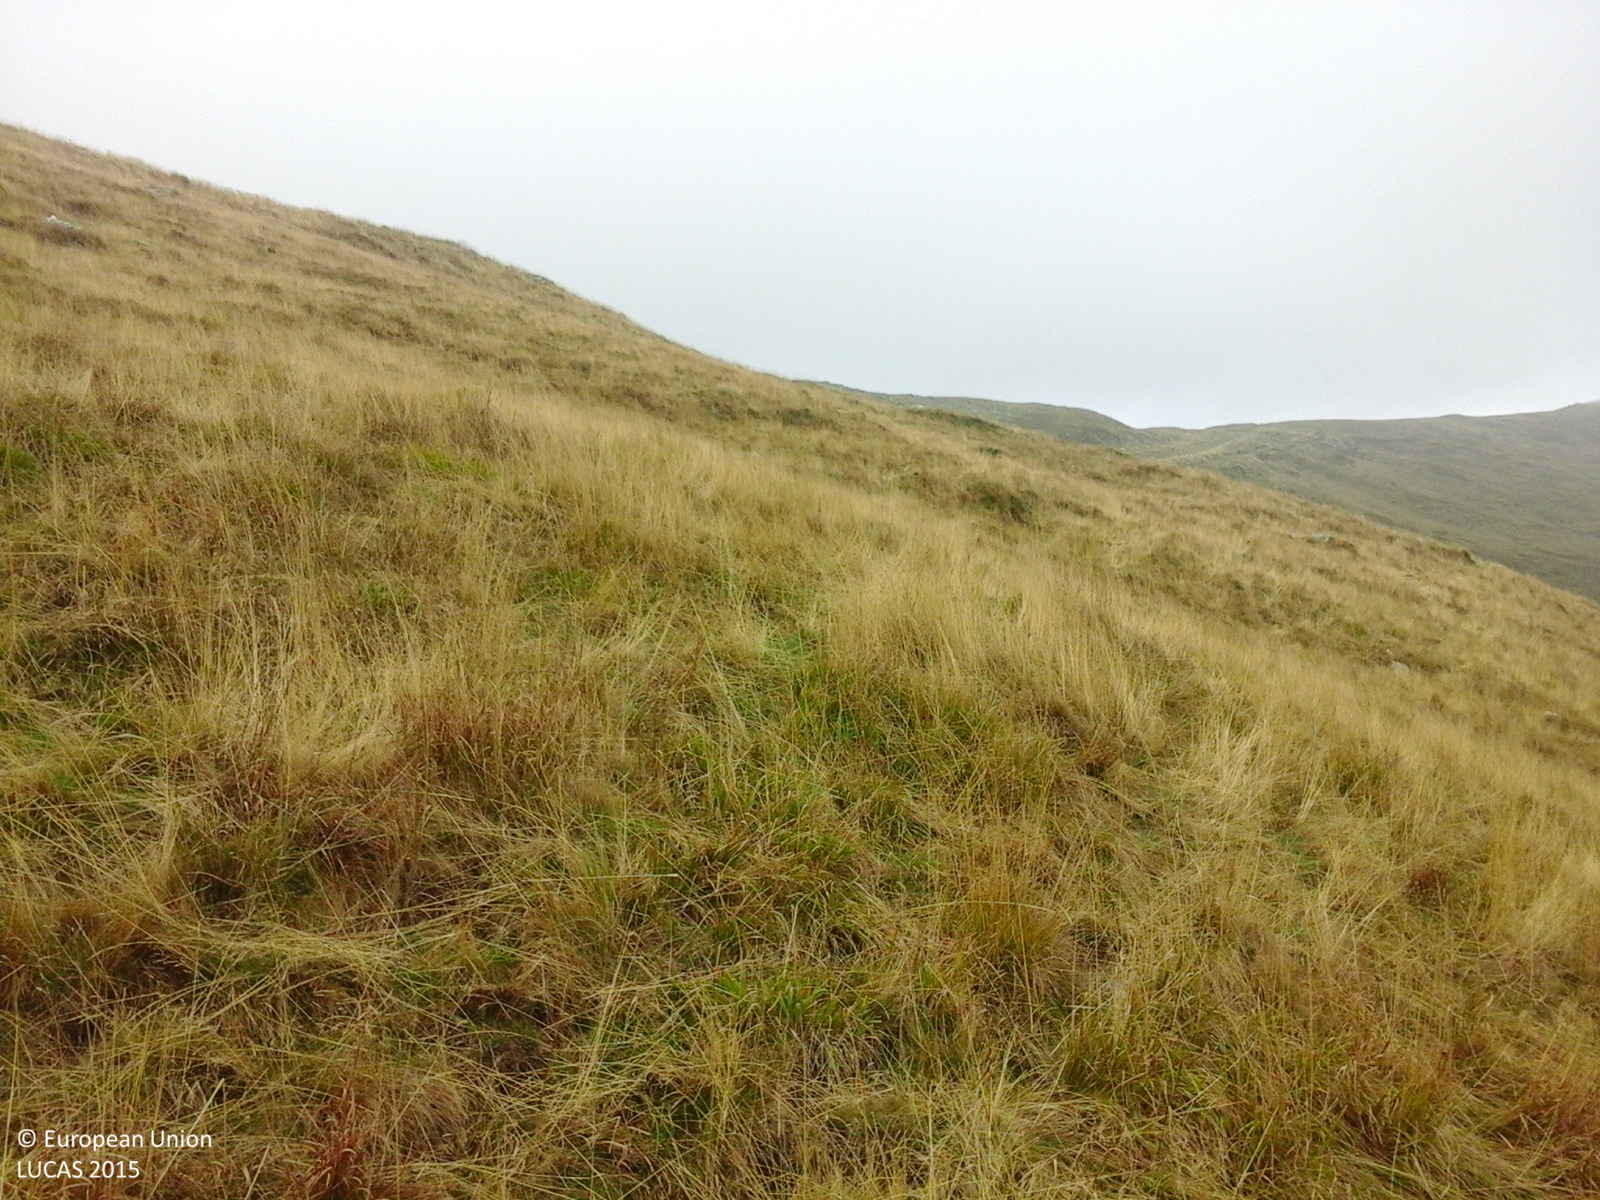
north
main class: Grassland
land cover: Grassland without tree/shrub cover
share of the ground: > 75 %
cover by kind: herbaceous plants 100 %
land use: Agriculture (excluding fallow land and kitchen gardens)
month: September
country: RO
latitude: 45.2966
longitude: 23.3054
